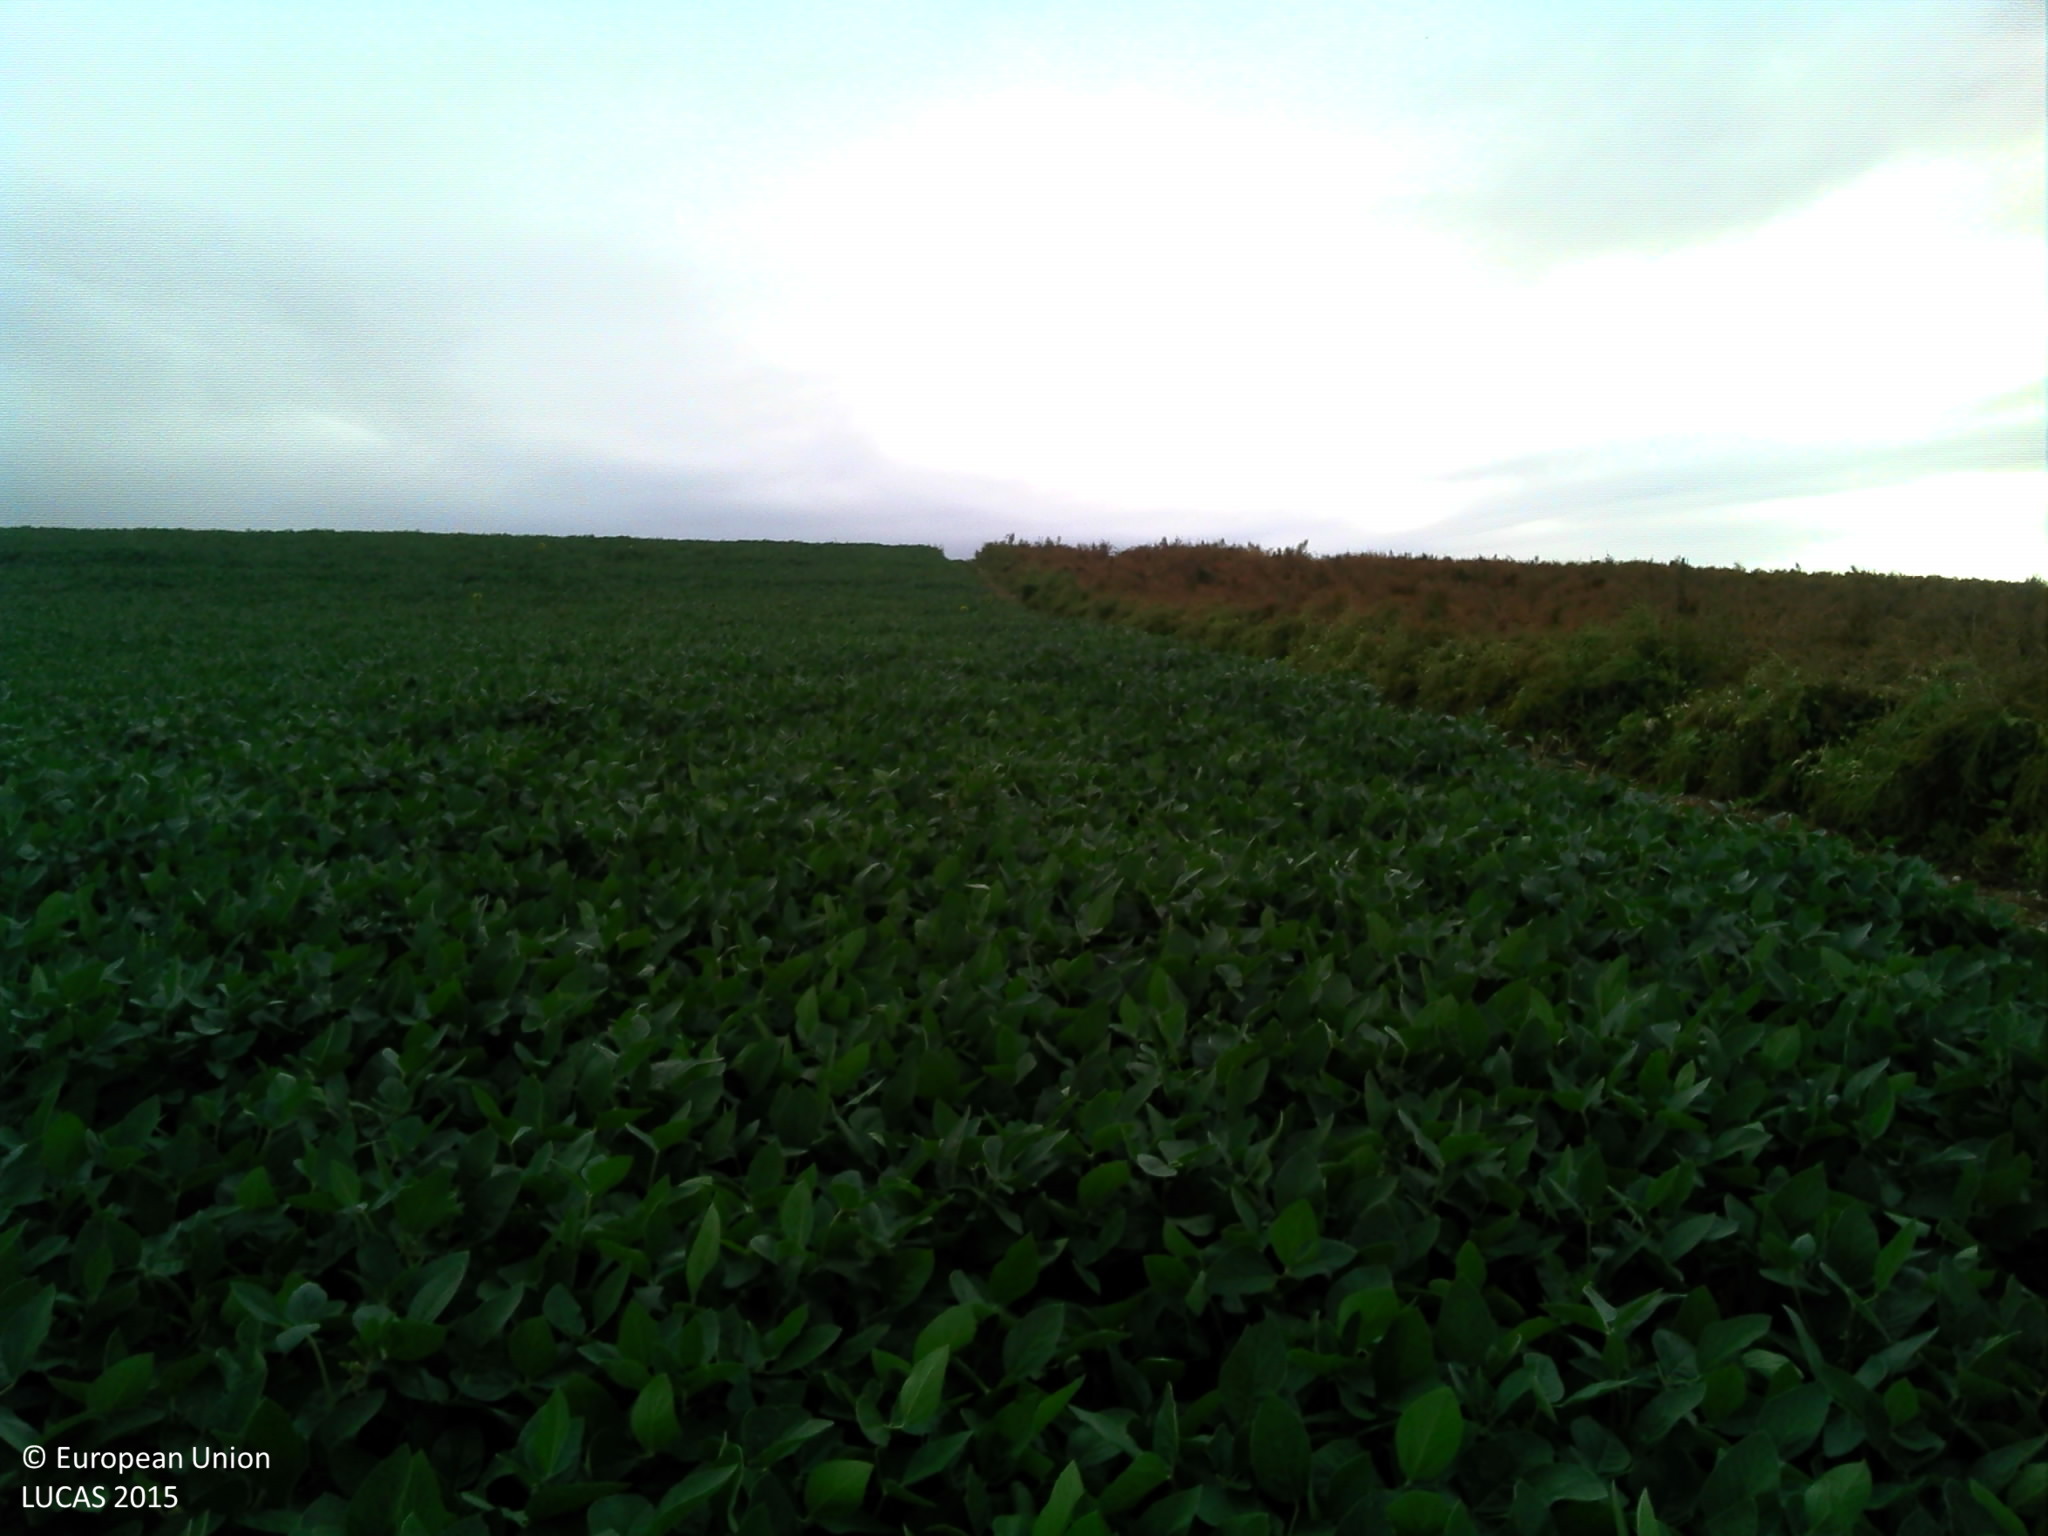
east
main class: Cropland
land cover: Soya
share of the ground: > 75 %
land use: Agriculture (excluding fallow land and kitchen gardens)
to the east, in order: Soya; Tracks; Sugar beet; Tracks; Sugar beet; Tracks; Sugar beet; Tracks; Sugar beet; Tracks; Sugar beet; Tracks; Sugar beet; Tracks; Sugar beet; Tracks; Sugar beet
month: July
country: FR
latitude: 44.2576
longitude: 0.8902
